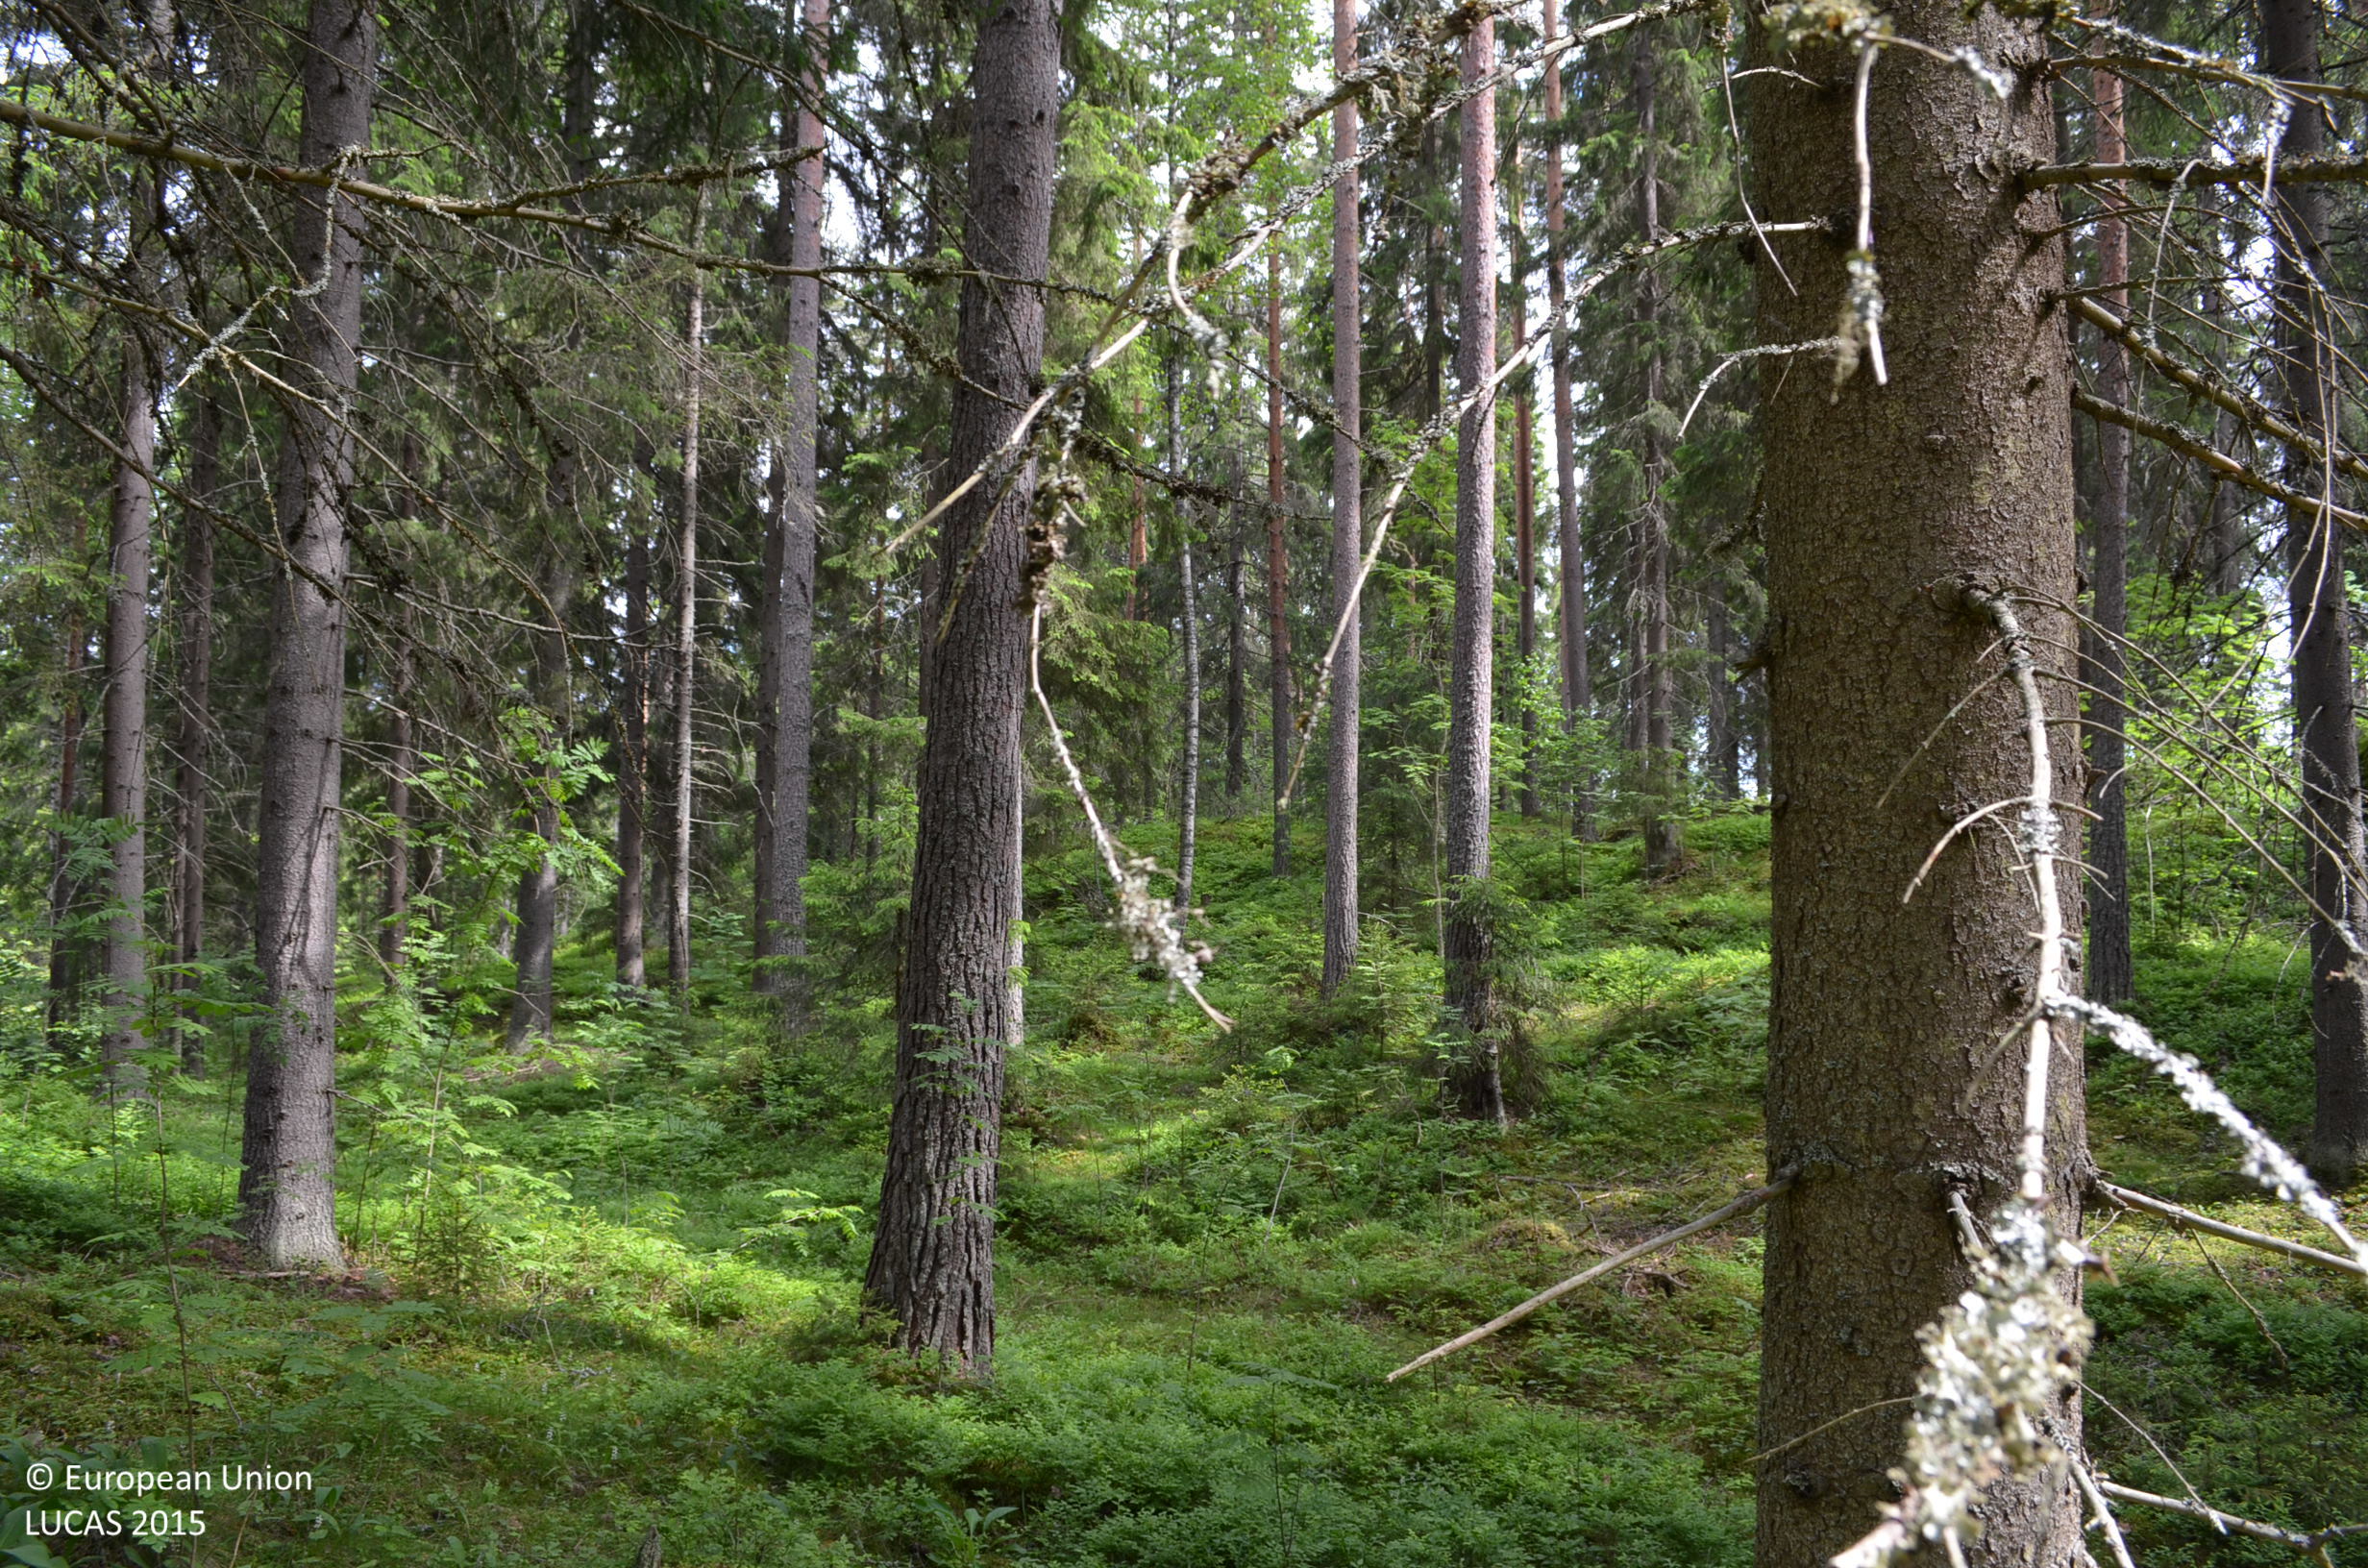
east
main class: Woodland
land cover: Other coniferous woodland
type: boreal forest
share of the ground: > 75 %
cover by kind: coniferous forest trees 80 %, shrubs 10 %, broadleaved forest trees 5 %, herbaceous plants 5 %
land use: Forestry
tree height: > 5 m
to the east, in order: Other coniferous woodland; Grass margins; Ditches and canals; Grass margins; Paved roads, cycling and walking lanes; Grass margins; Ditches and canals; Spruce dominated coniferous woodland; Grassland with sparse tree/shrub cover; Spruce dominated coniferous woodland
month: June
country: FI
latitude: 61.7818
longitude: 23.2875
